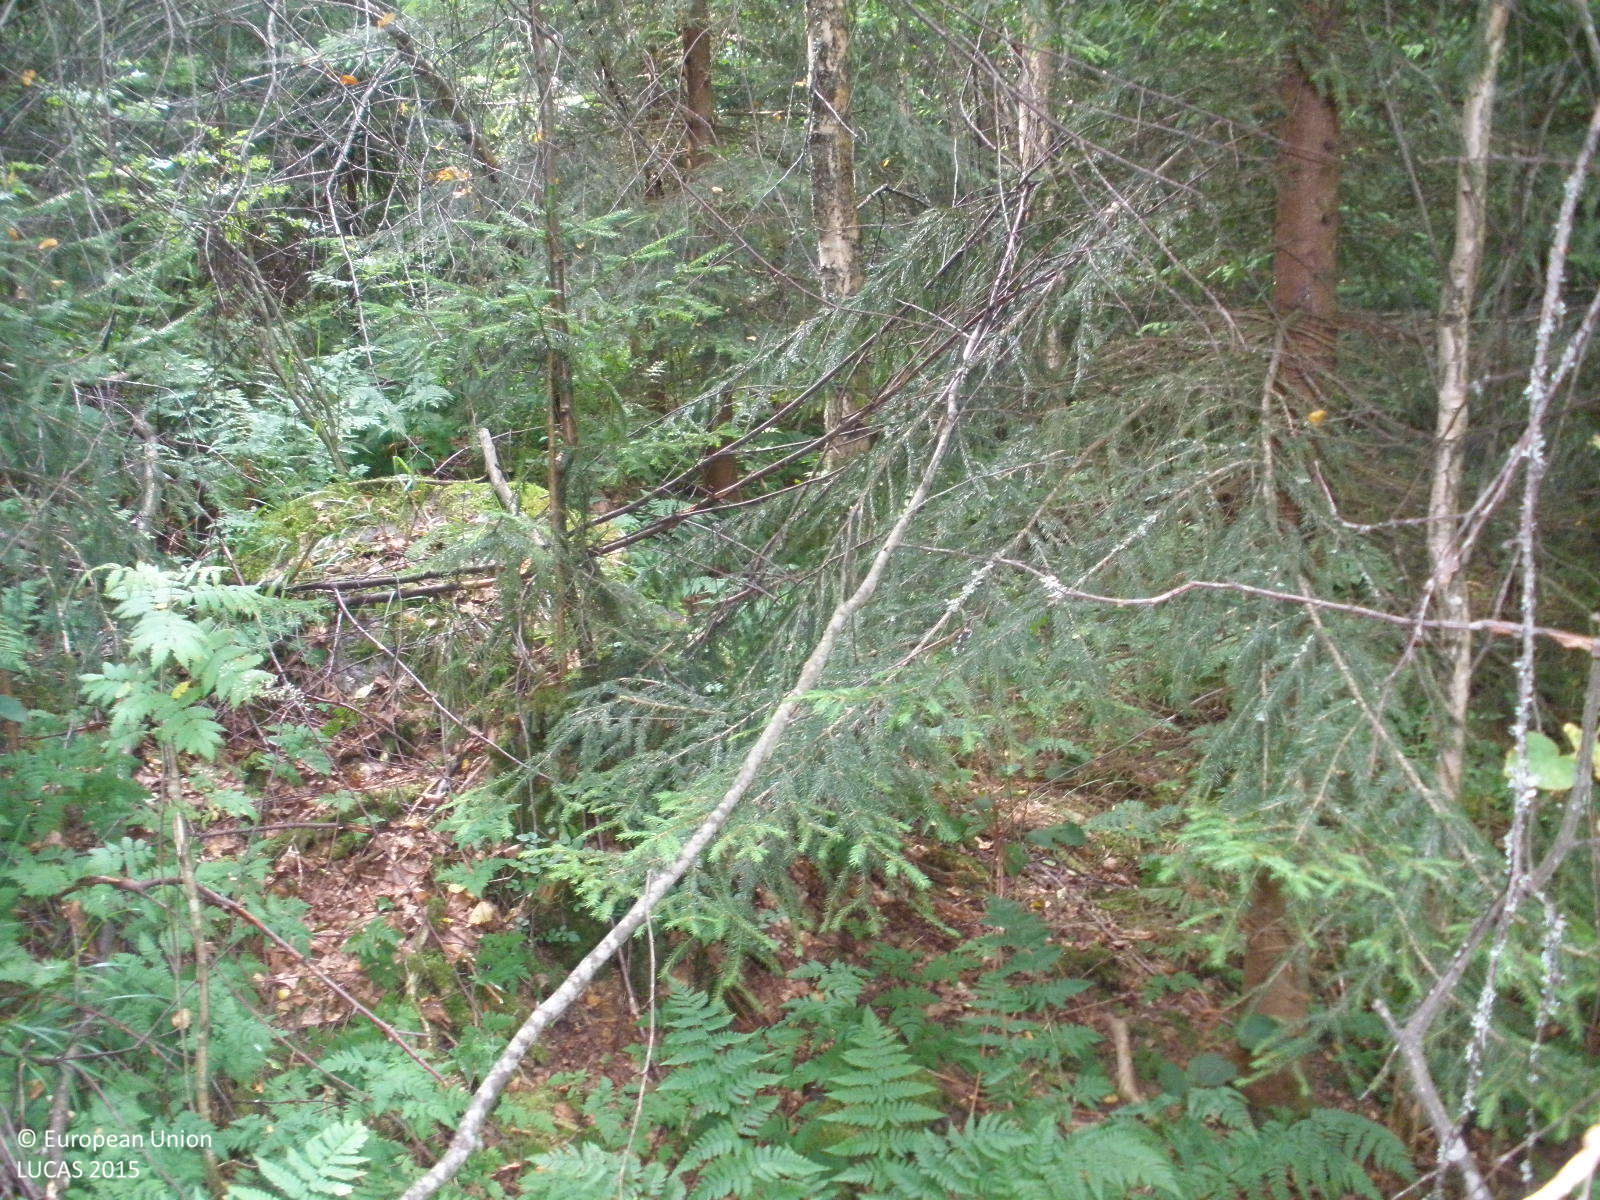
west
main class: Woodland
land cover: Spruce dominated mixed woodland
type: boreal forest
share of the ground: > 75 %
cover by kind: broadleaved forest trees 45 %, coniferous forest trees 30 %, herbaceous plants 15 %, lichens and mosses 10 %
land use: Forestry
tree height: > 5 m
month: August
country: FI
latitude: 60.8031
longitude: 24.4933
